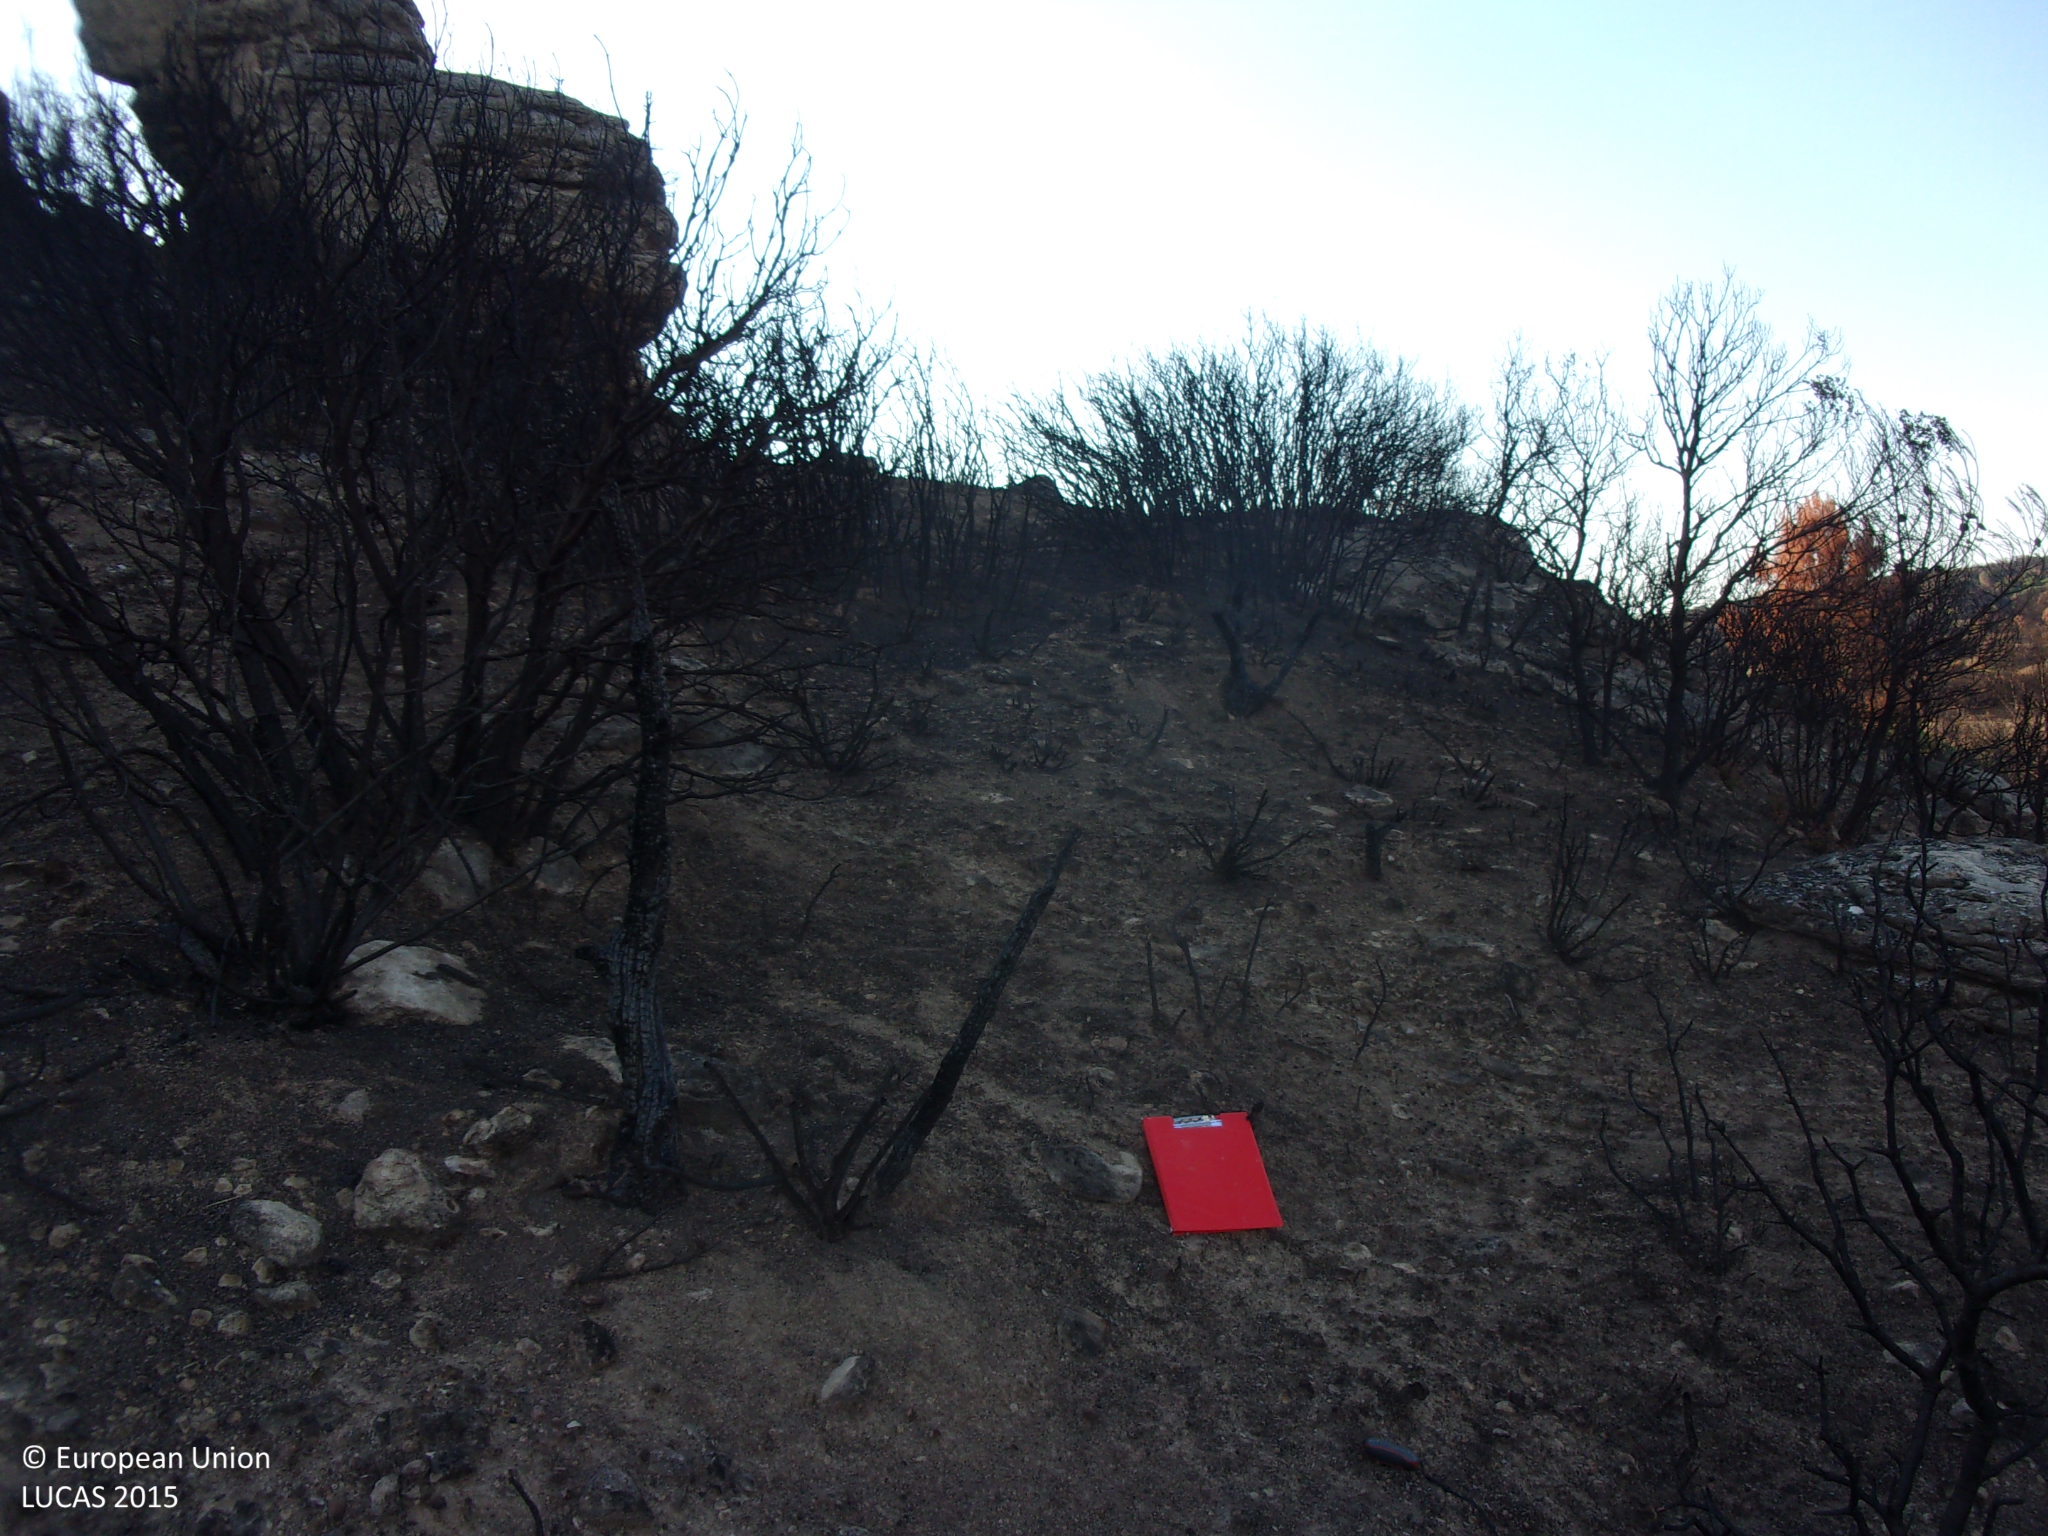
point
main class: Shrubland
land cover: Shrubland with sparse tree cover
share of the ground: 10 - 25 %
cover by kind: unconsolidated bare surface 75 %, shrubs 20 %, broadleaved forest trees 5 %
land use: Semi-natural and natural areas not in use
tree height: < 5 m
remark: Burnt area
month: August
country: ES
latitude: 42.2814
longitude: -1.0761
